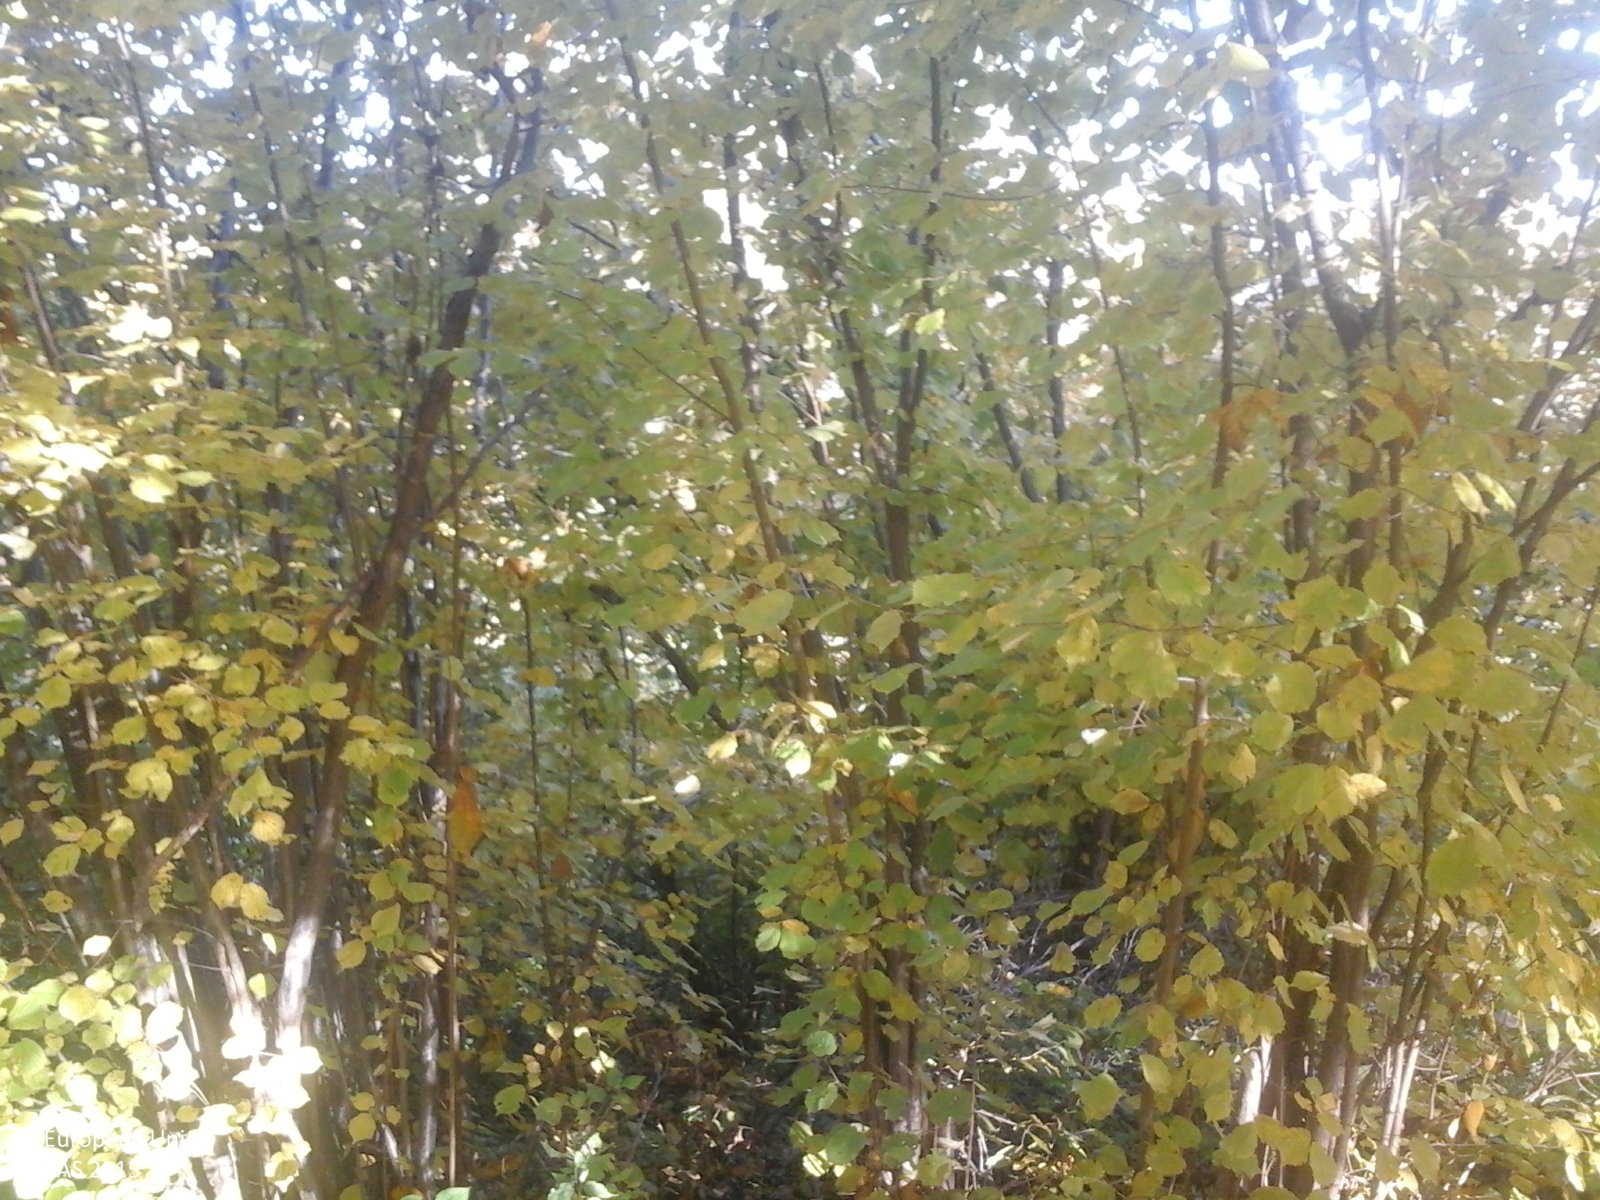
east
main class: Woodland
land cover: Broadleaved woodland
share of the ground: > 75 %
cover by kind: broadleaved forest trees 100 %
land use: Forestry
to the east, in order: Broadleaved woodland; Grassland without tree/shrub cover; Broadleaved woodland; Tracks; Broadleaved woodland; Grassland without tree/shrub cover; Fences; Grassland without tree/shrub cover; Broadleaved woodland; Grassland without tree/shrub cover
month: October
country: RO
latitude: 45.8601
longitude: 26.6580
